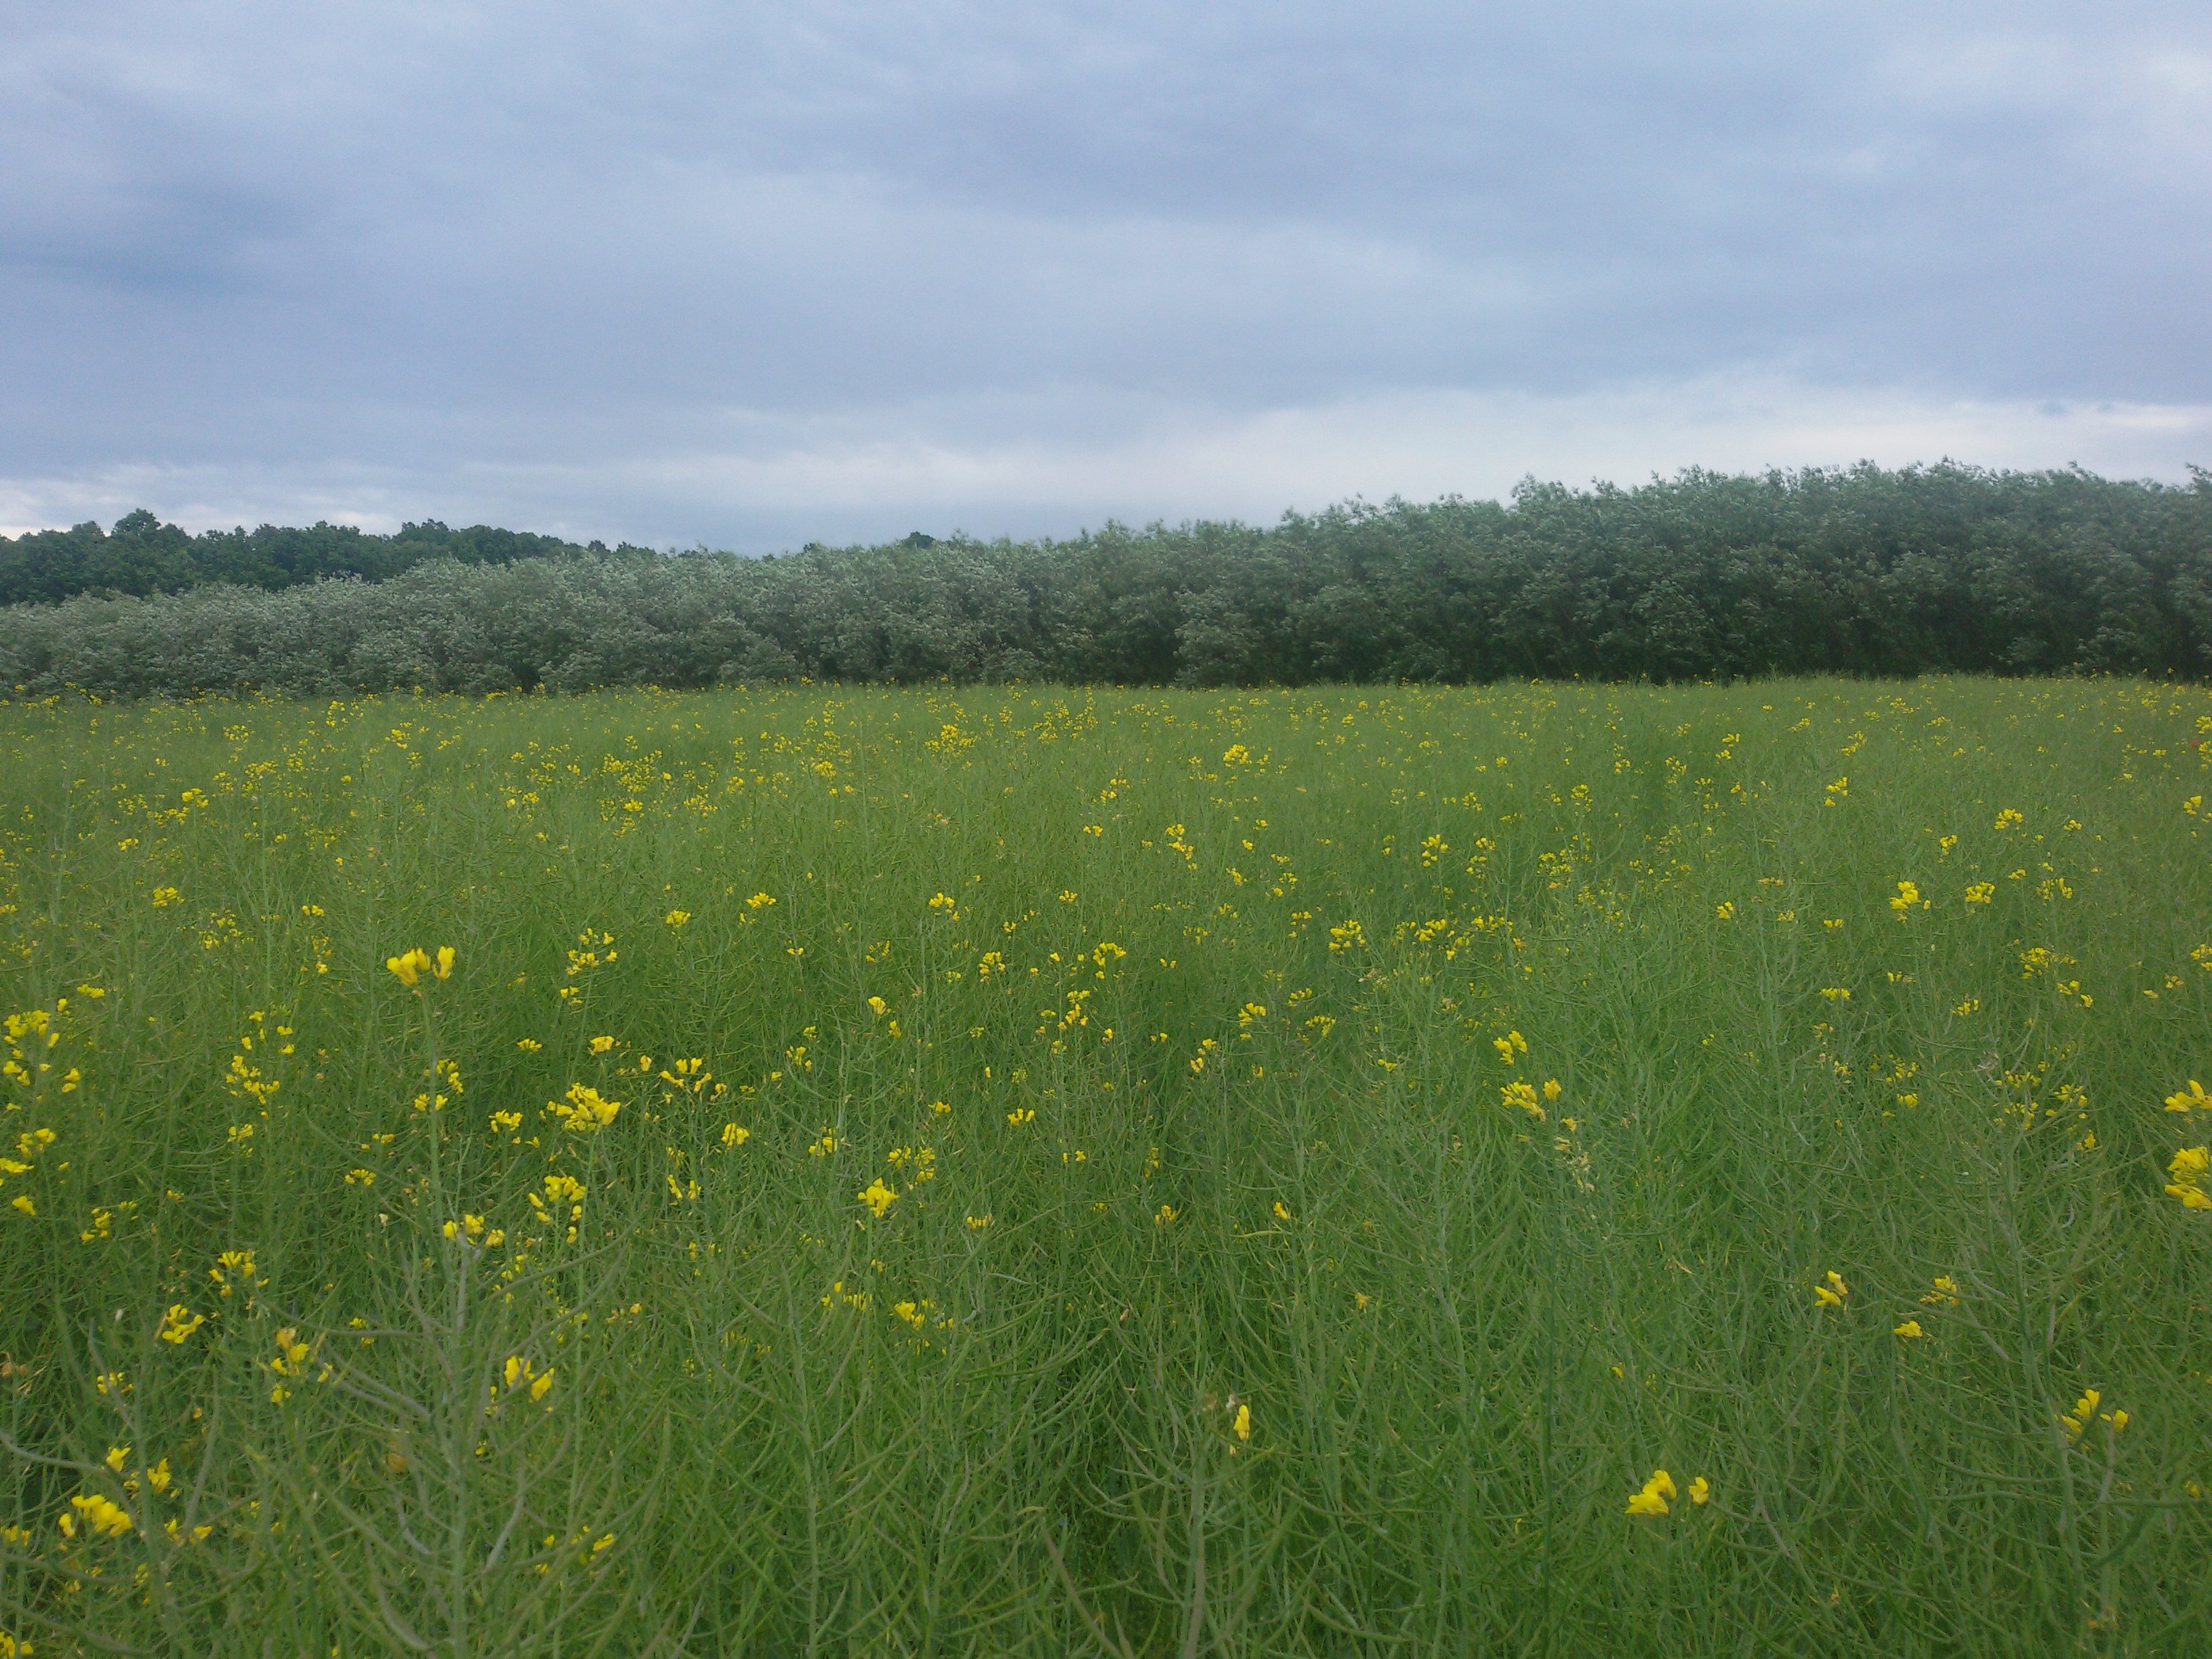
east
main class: Cropland
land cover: Rape and turnip rape
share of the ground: > 75 %
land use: Agriculture (excluding fallow land and kitchen gardens)
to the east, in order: Rape and turnip rape; Tracks; Permanent industrial crops
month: May
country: PL
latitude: 50.3881
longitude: 17.2265
